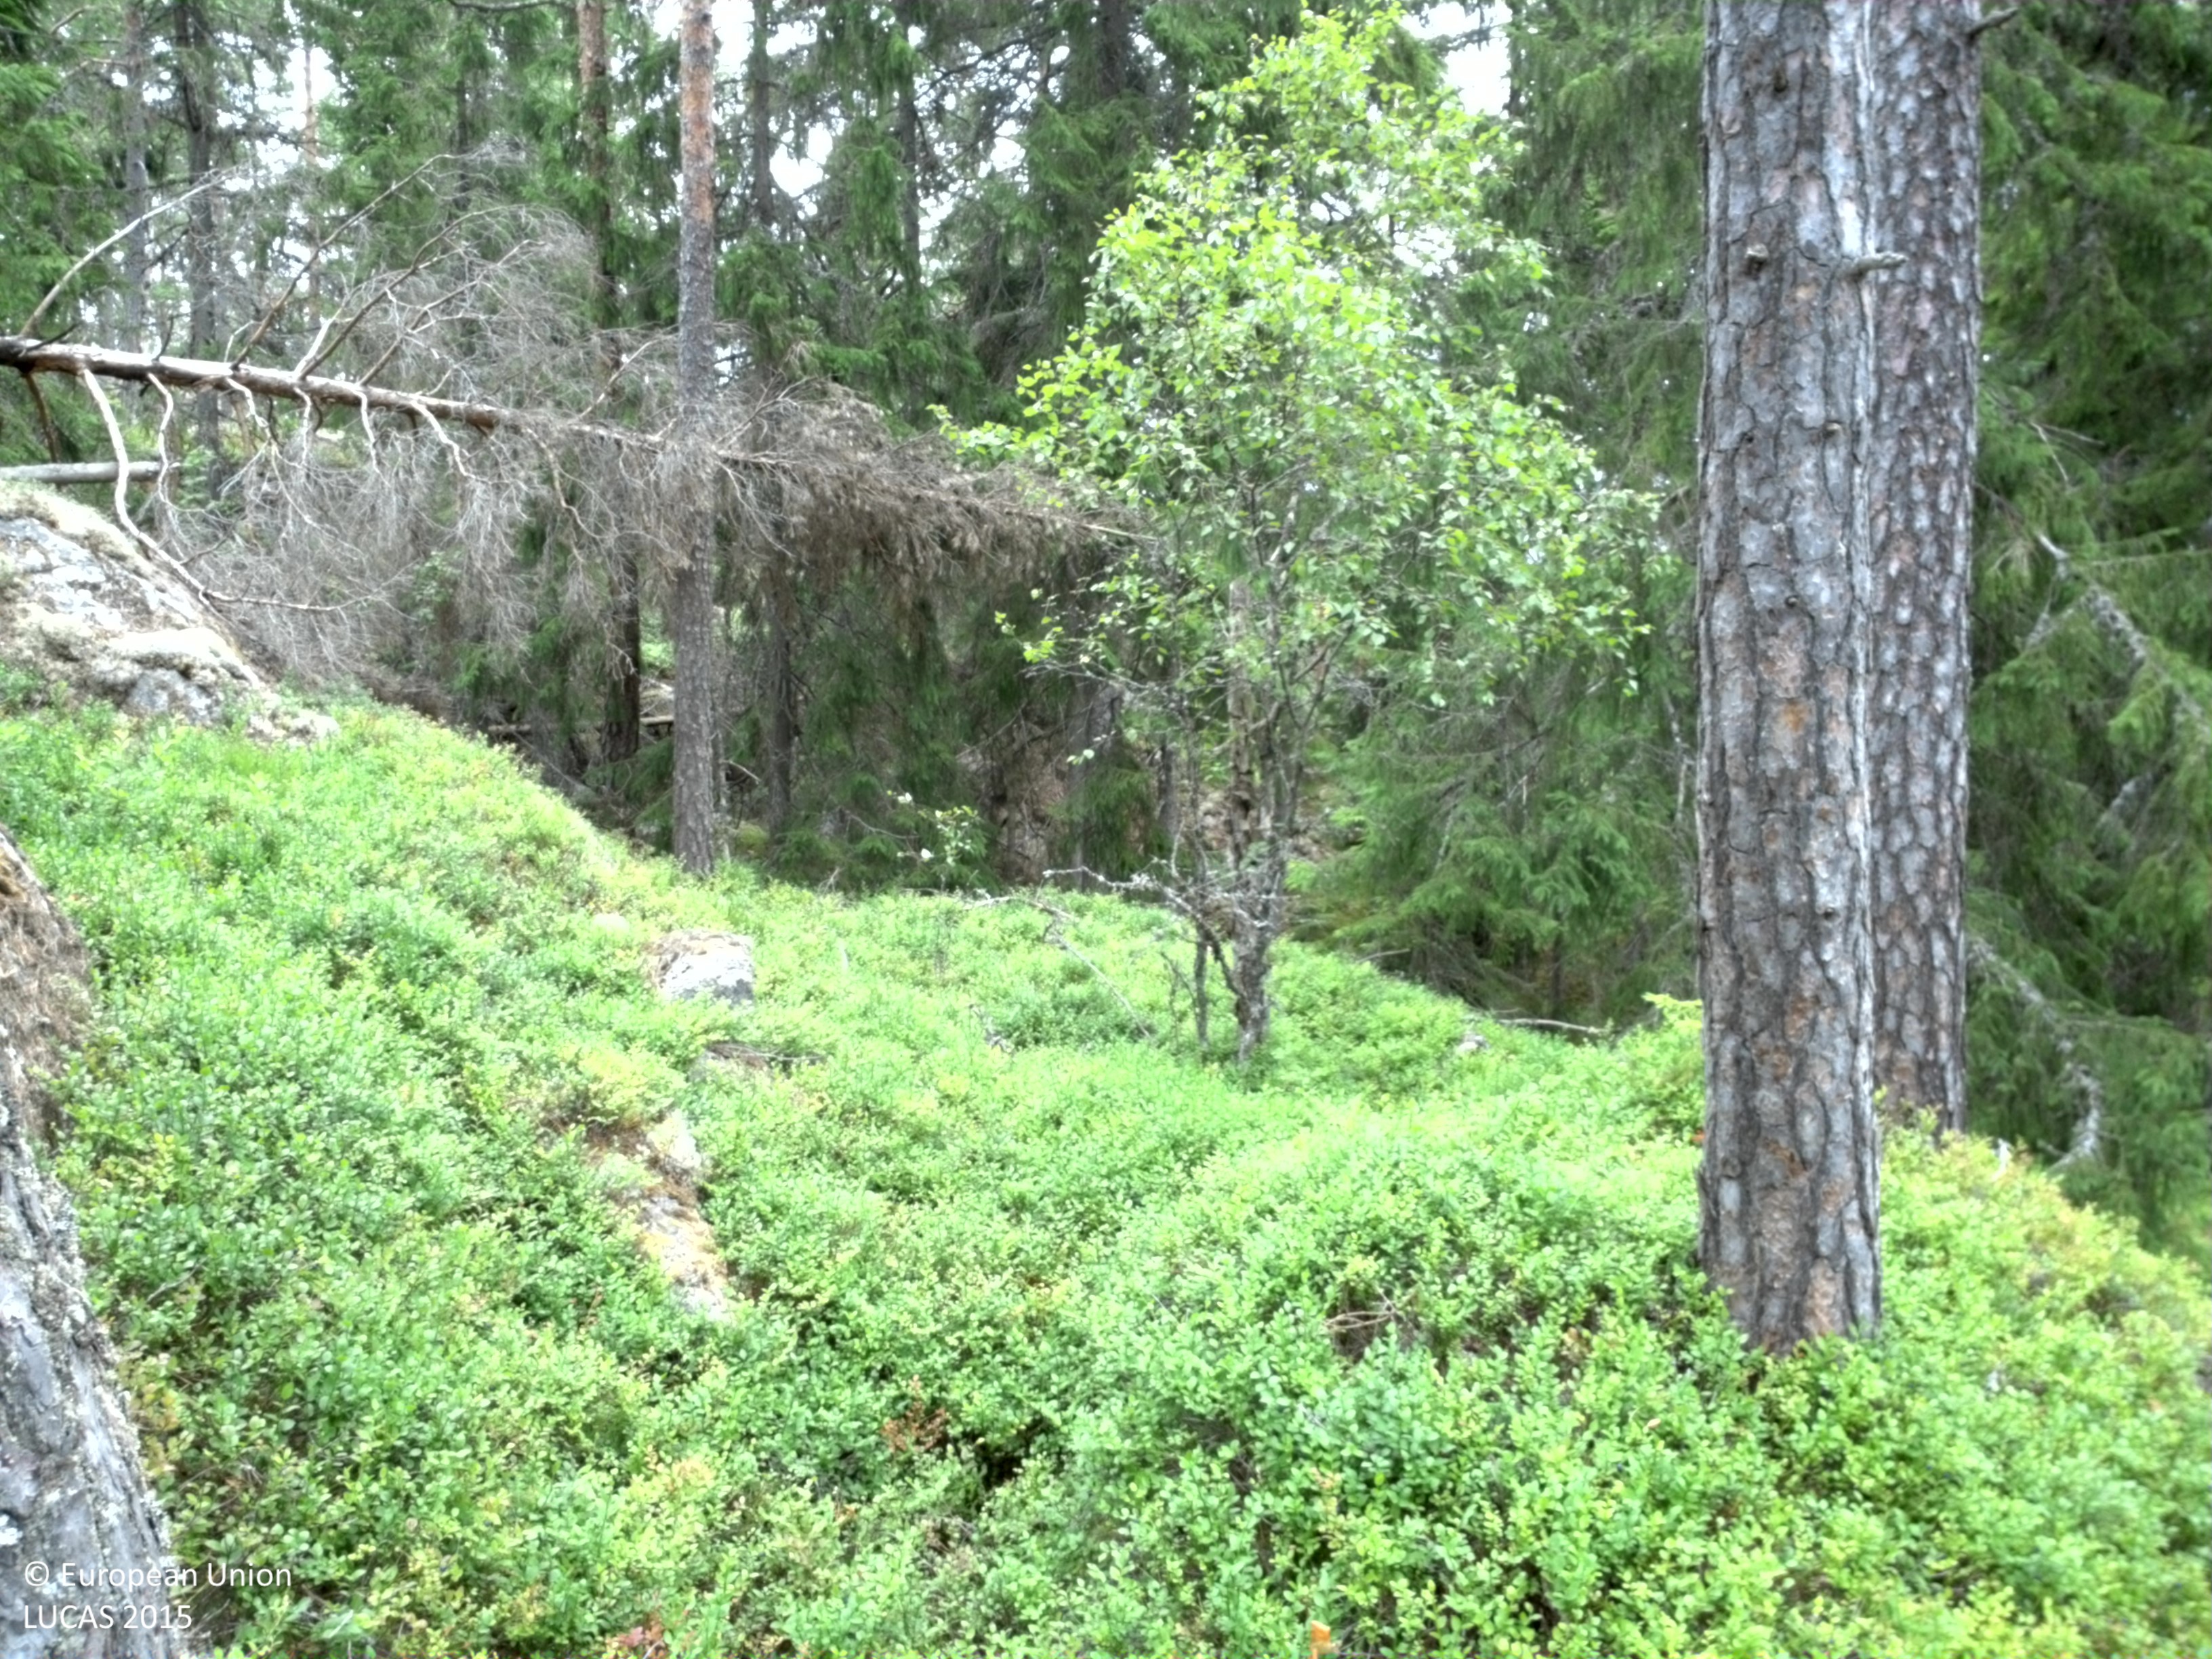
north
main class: Woodland
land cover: Pine dominated coniferous woodland
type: boreal forest
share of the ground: 10 - 25 %
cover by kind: herbaceous plants 50 %, lichens and mosses 30 %, coniferous forest trees 20 %
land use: Forestry
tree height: > 5 m
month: July
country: SE
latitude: 58.7794
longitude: 15.3725
